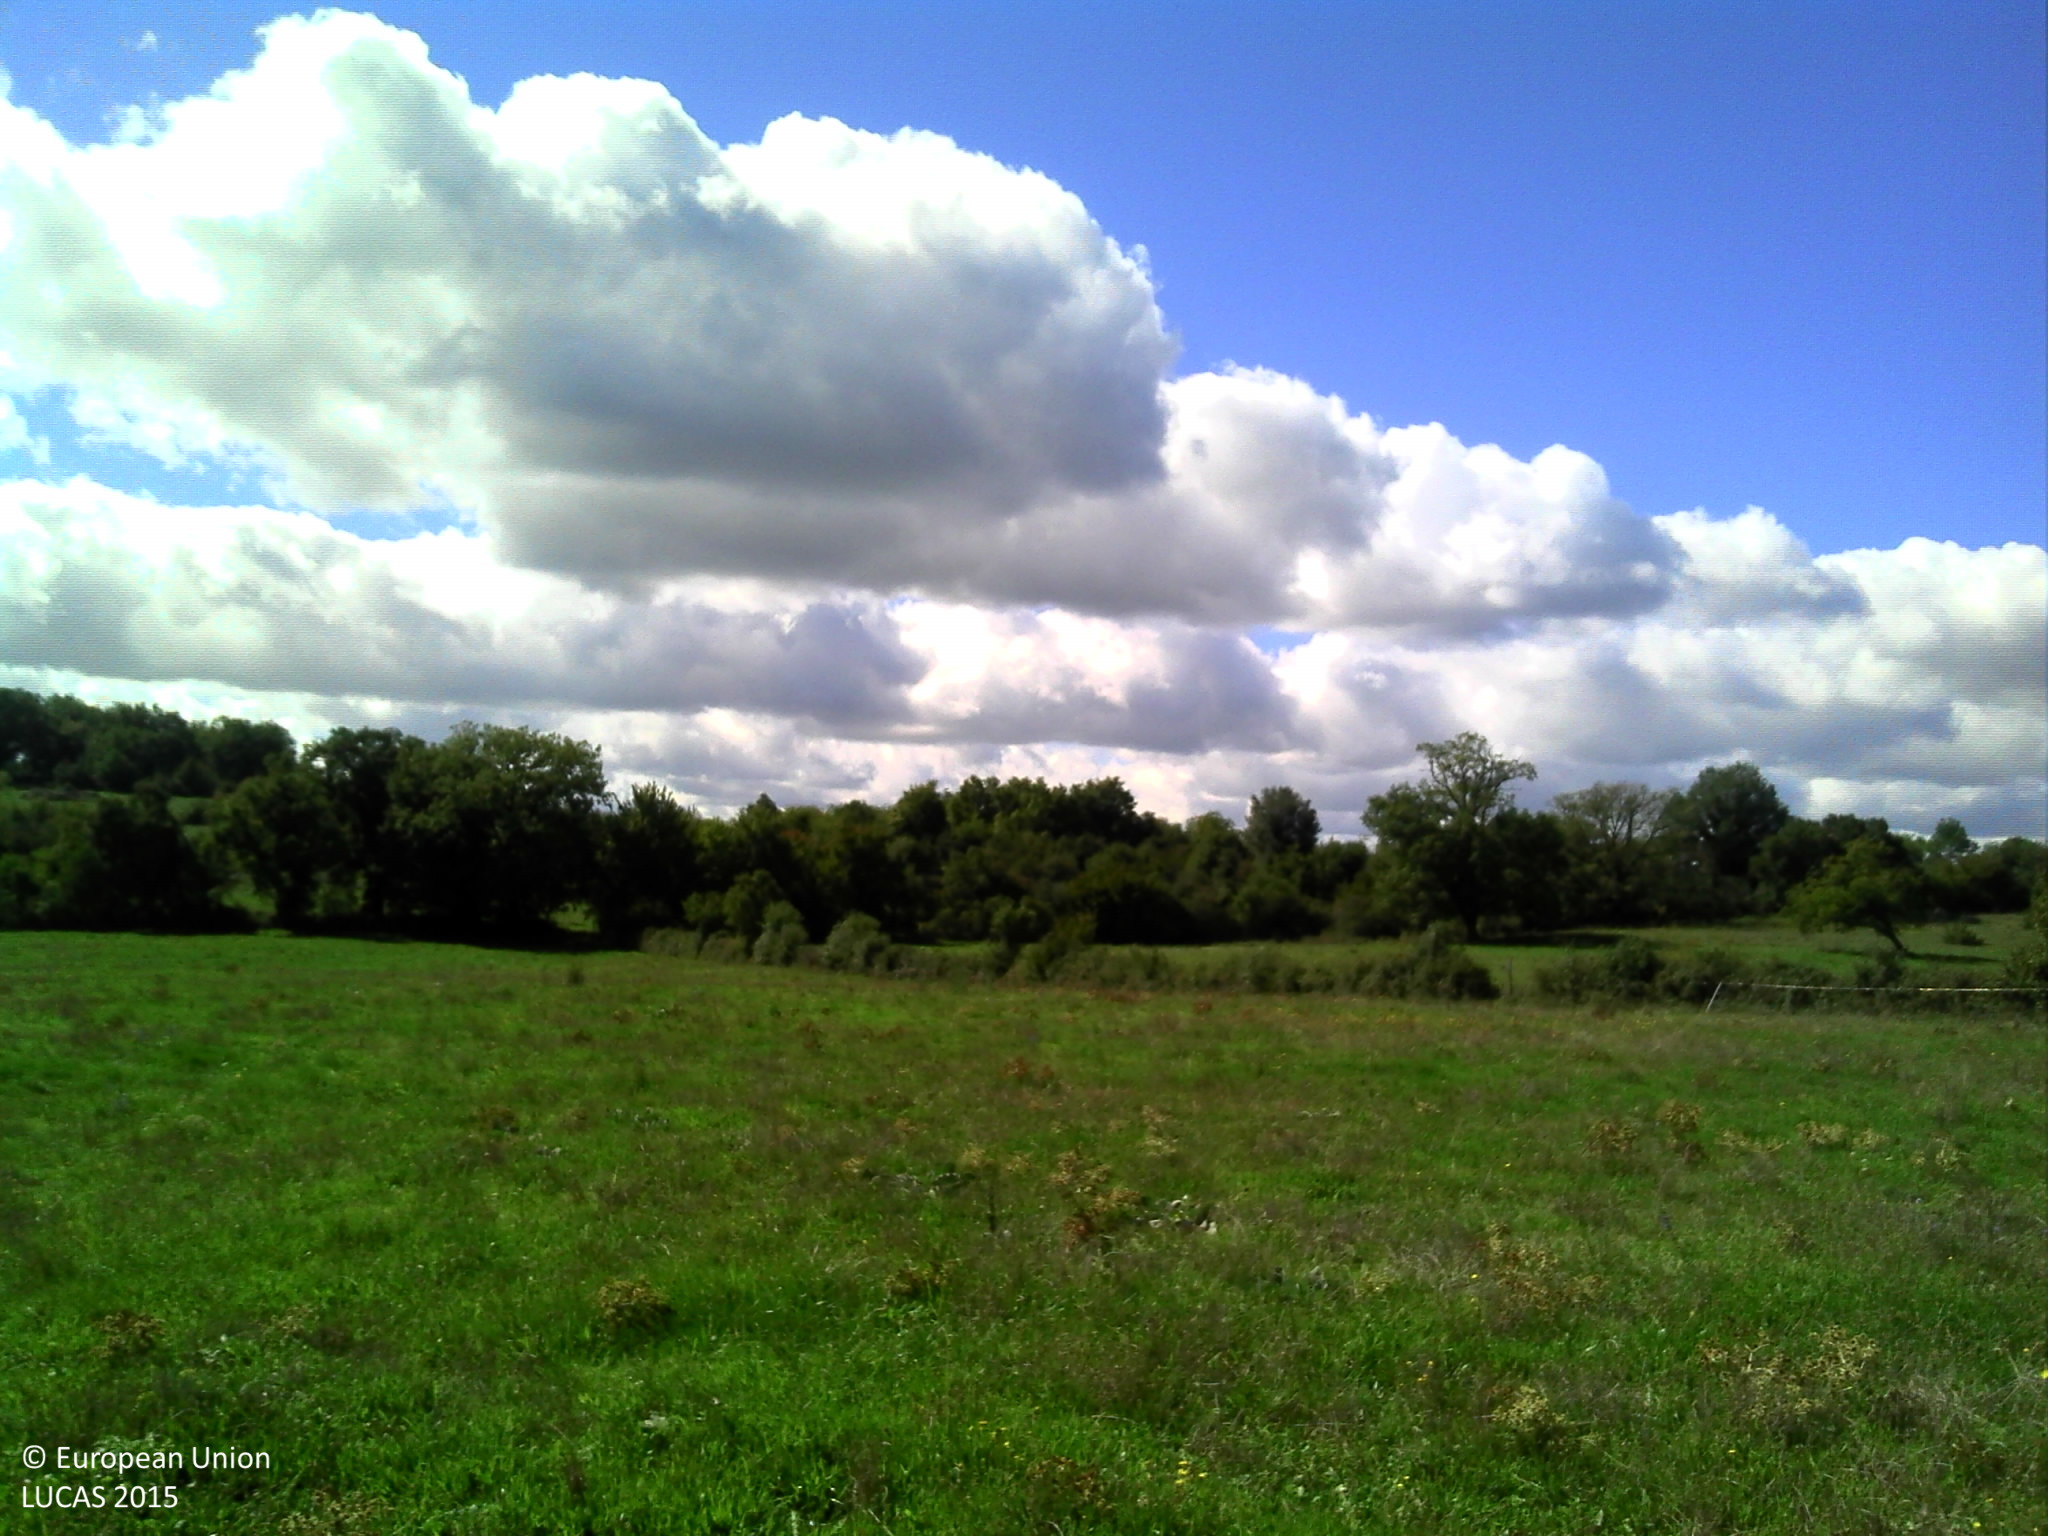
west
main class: Grassland
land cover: Grassland without tree/shrub cover
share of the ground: > 75 %
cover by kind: herbaceous plants 100 %
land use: Agriculture (excluding fallow land and kitchen gardens)
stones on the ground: < 10 %
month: September
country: FR
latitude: 44.7664
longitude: 1.7732
